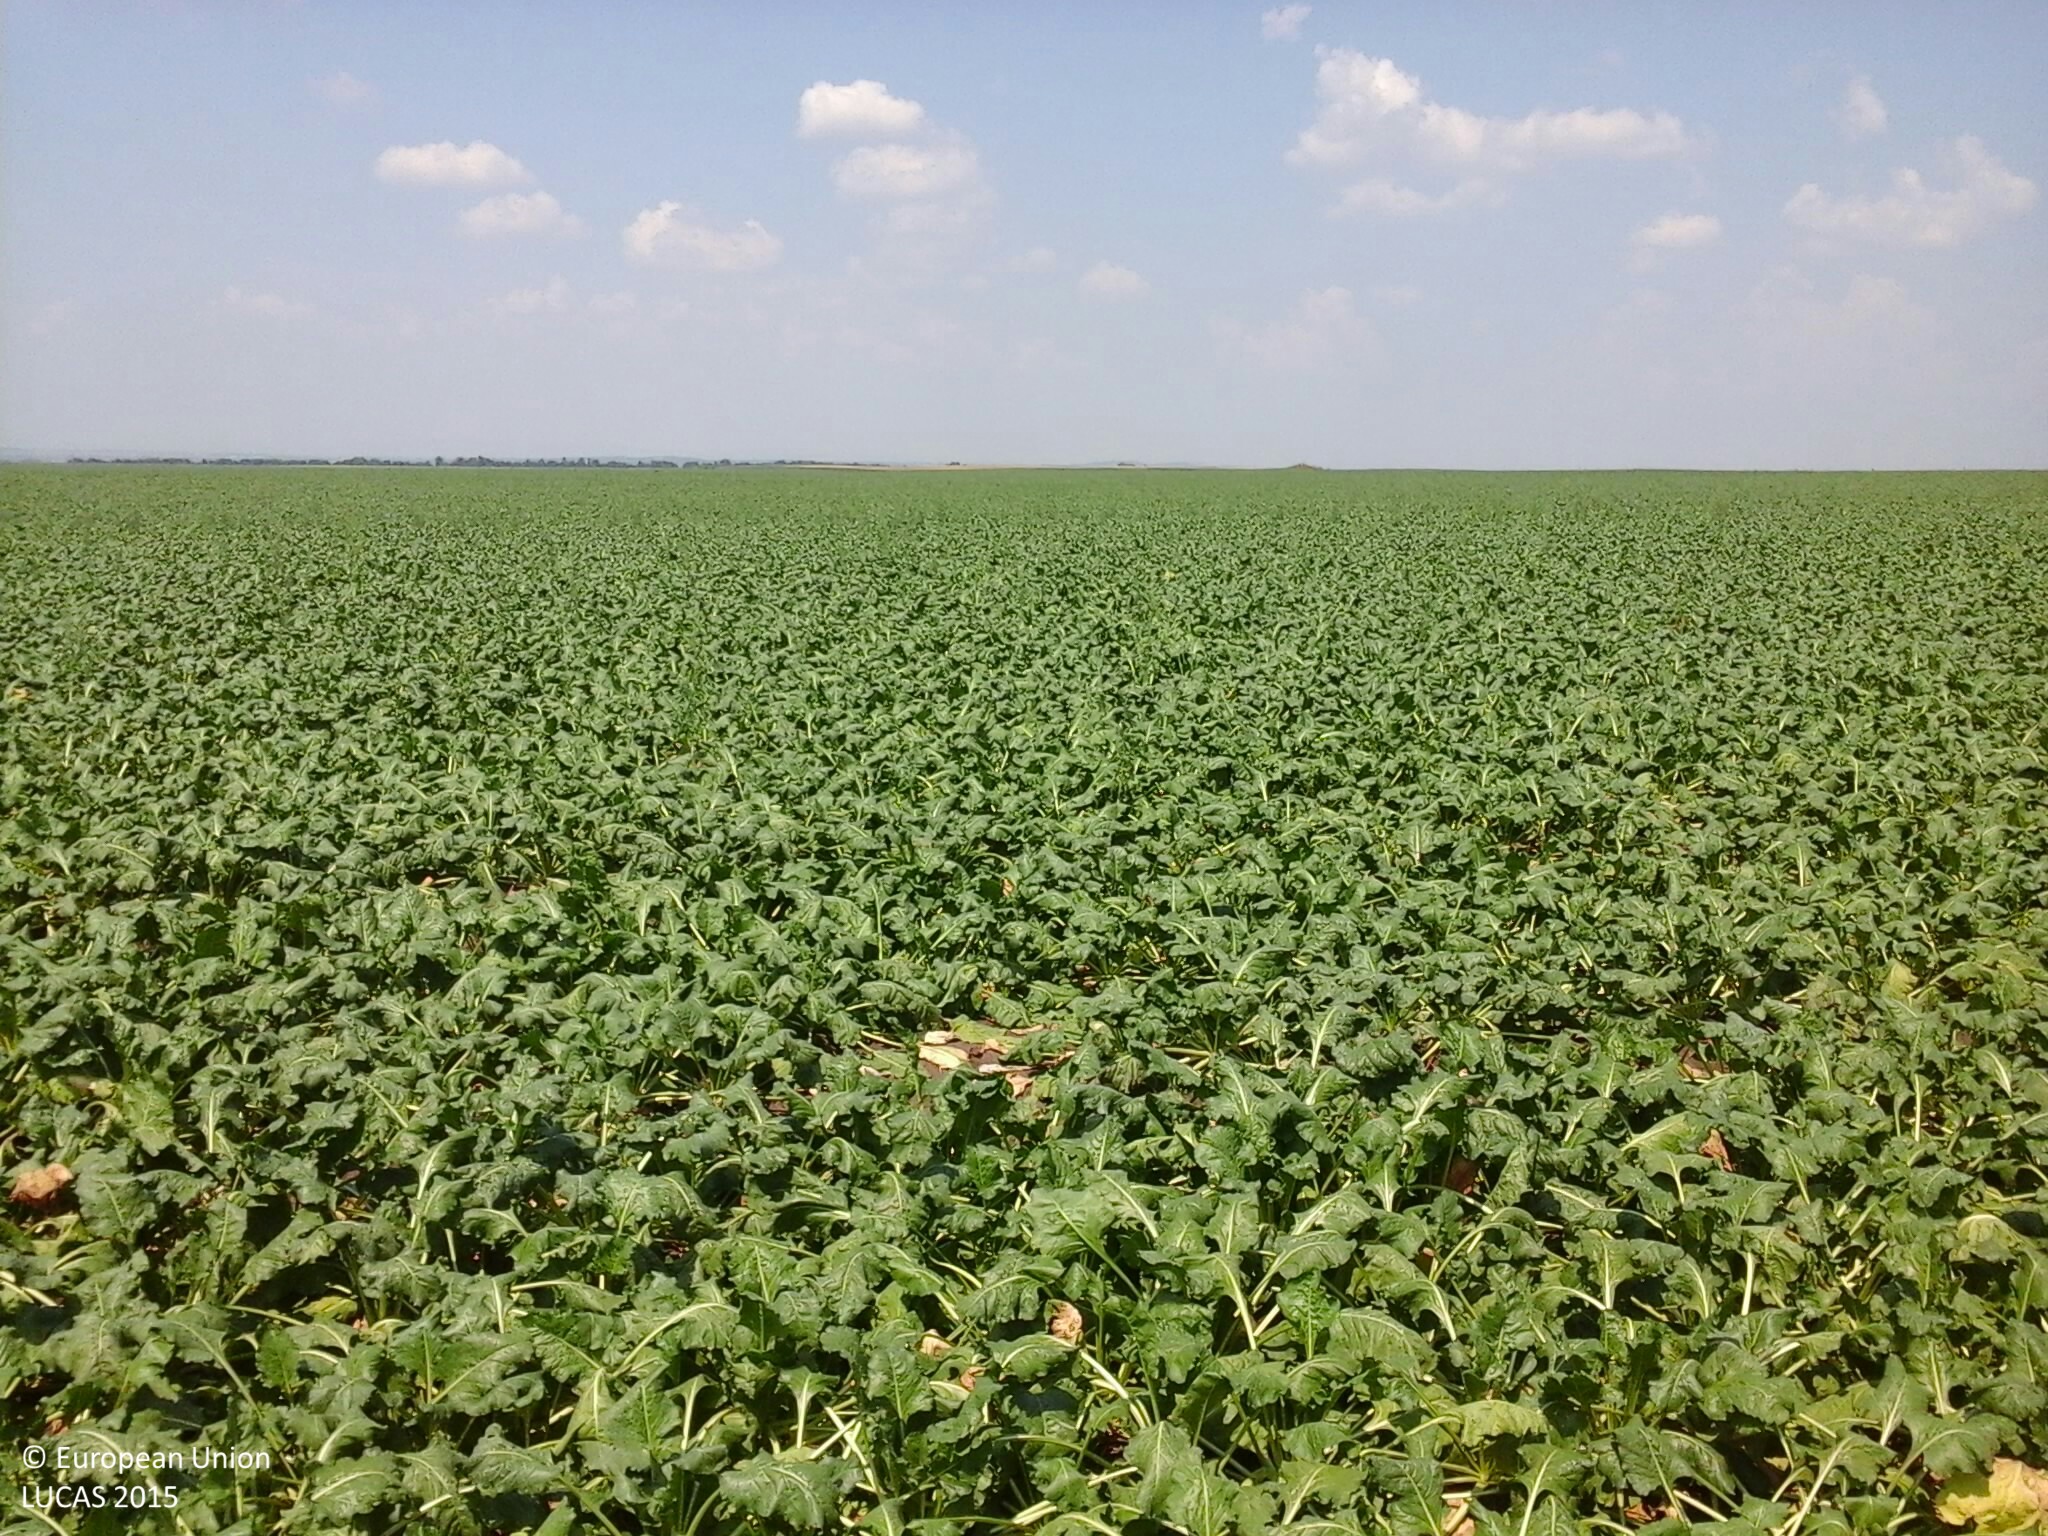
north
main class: Cropland
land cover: Sugar beet
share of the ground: > 75 %
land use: Agriculture (excluding fallow land and kitchen gardens)
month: August
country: HU
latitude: 46.9333
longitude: 18.2987
